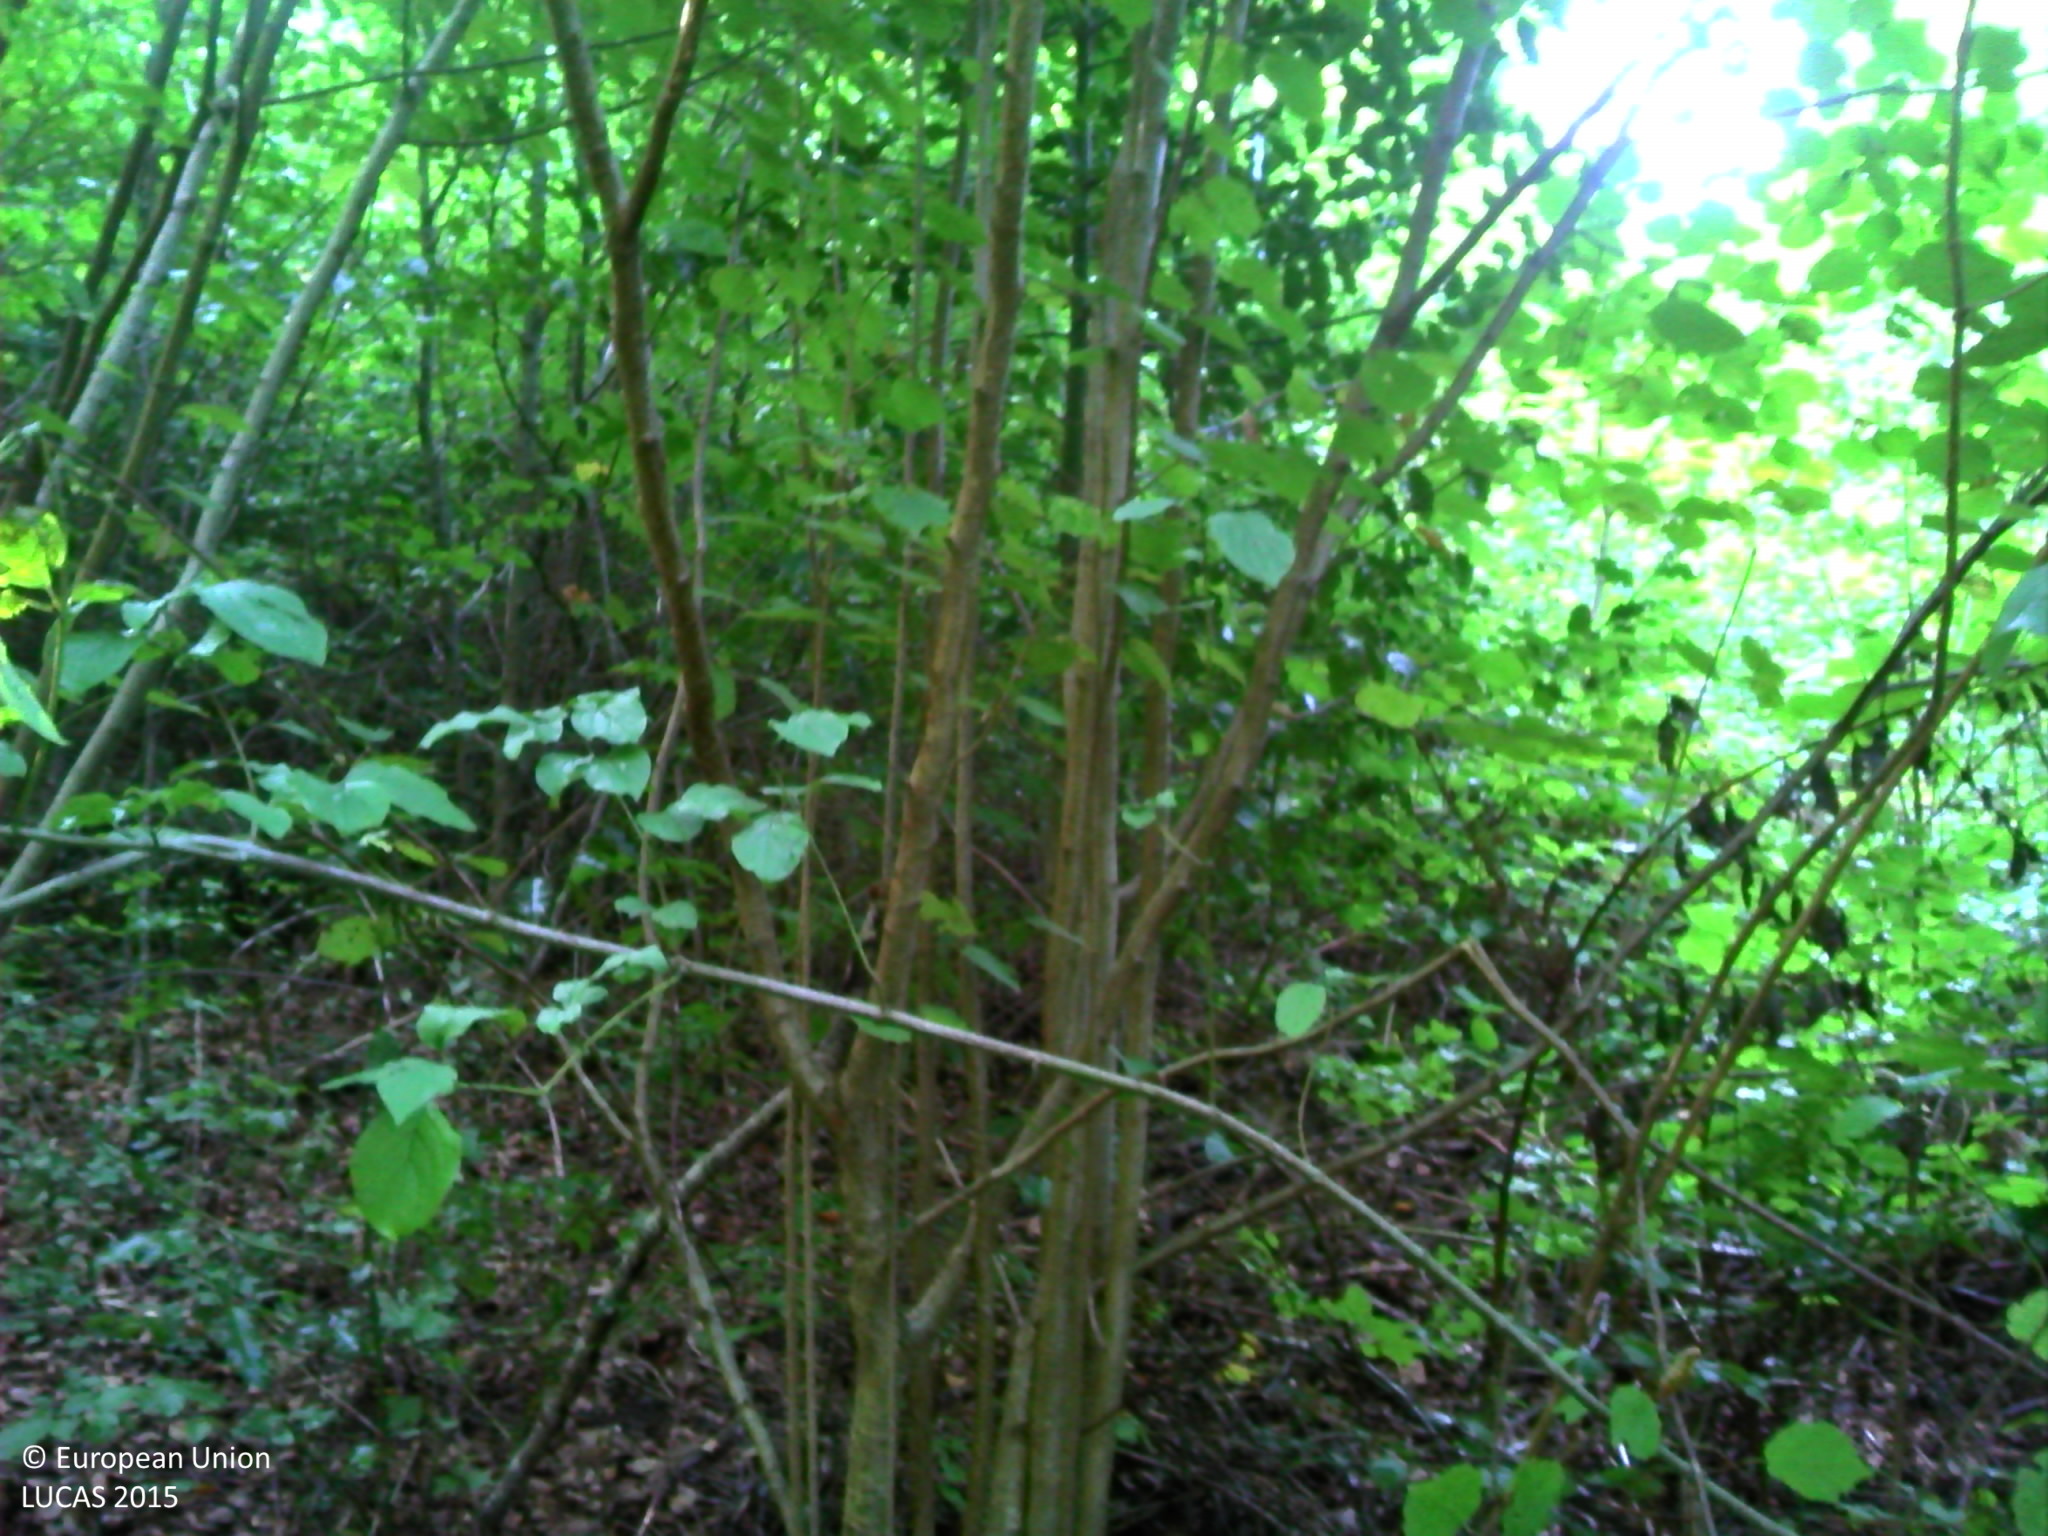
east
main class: Woodland
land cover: Broadleaved woodland
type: beech forest
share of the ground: > 75 %
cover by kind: broadleaved forest trees 90 %, consolidated bare surface 5 %
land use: Forestry
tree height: > 5 m
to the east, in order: Broadleaved woodland; Tracks; Broadleaved woodland; Tracks; Broadleaved woodland
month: September
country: FR
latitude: 47.2449
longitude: 6.3687
